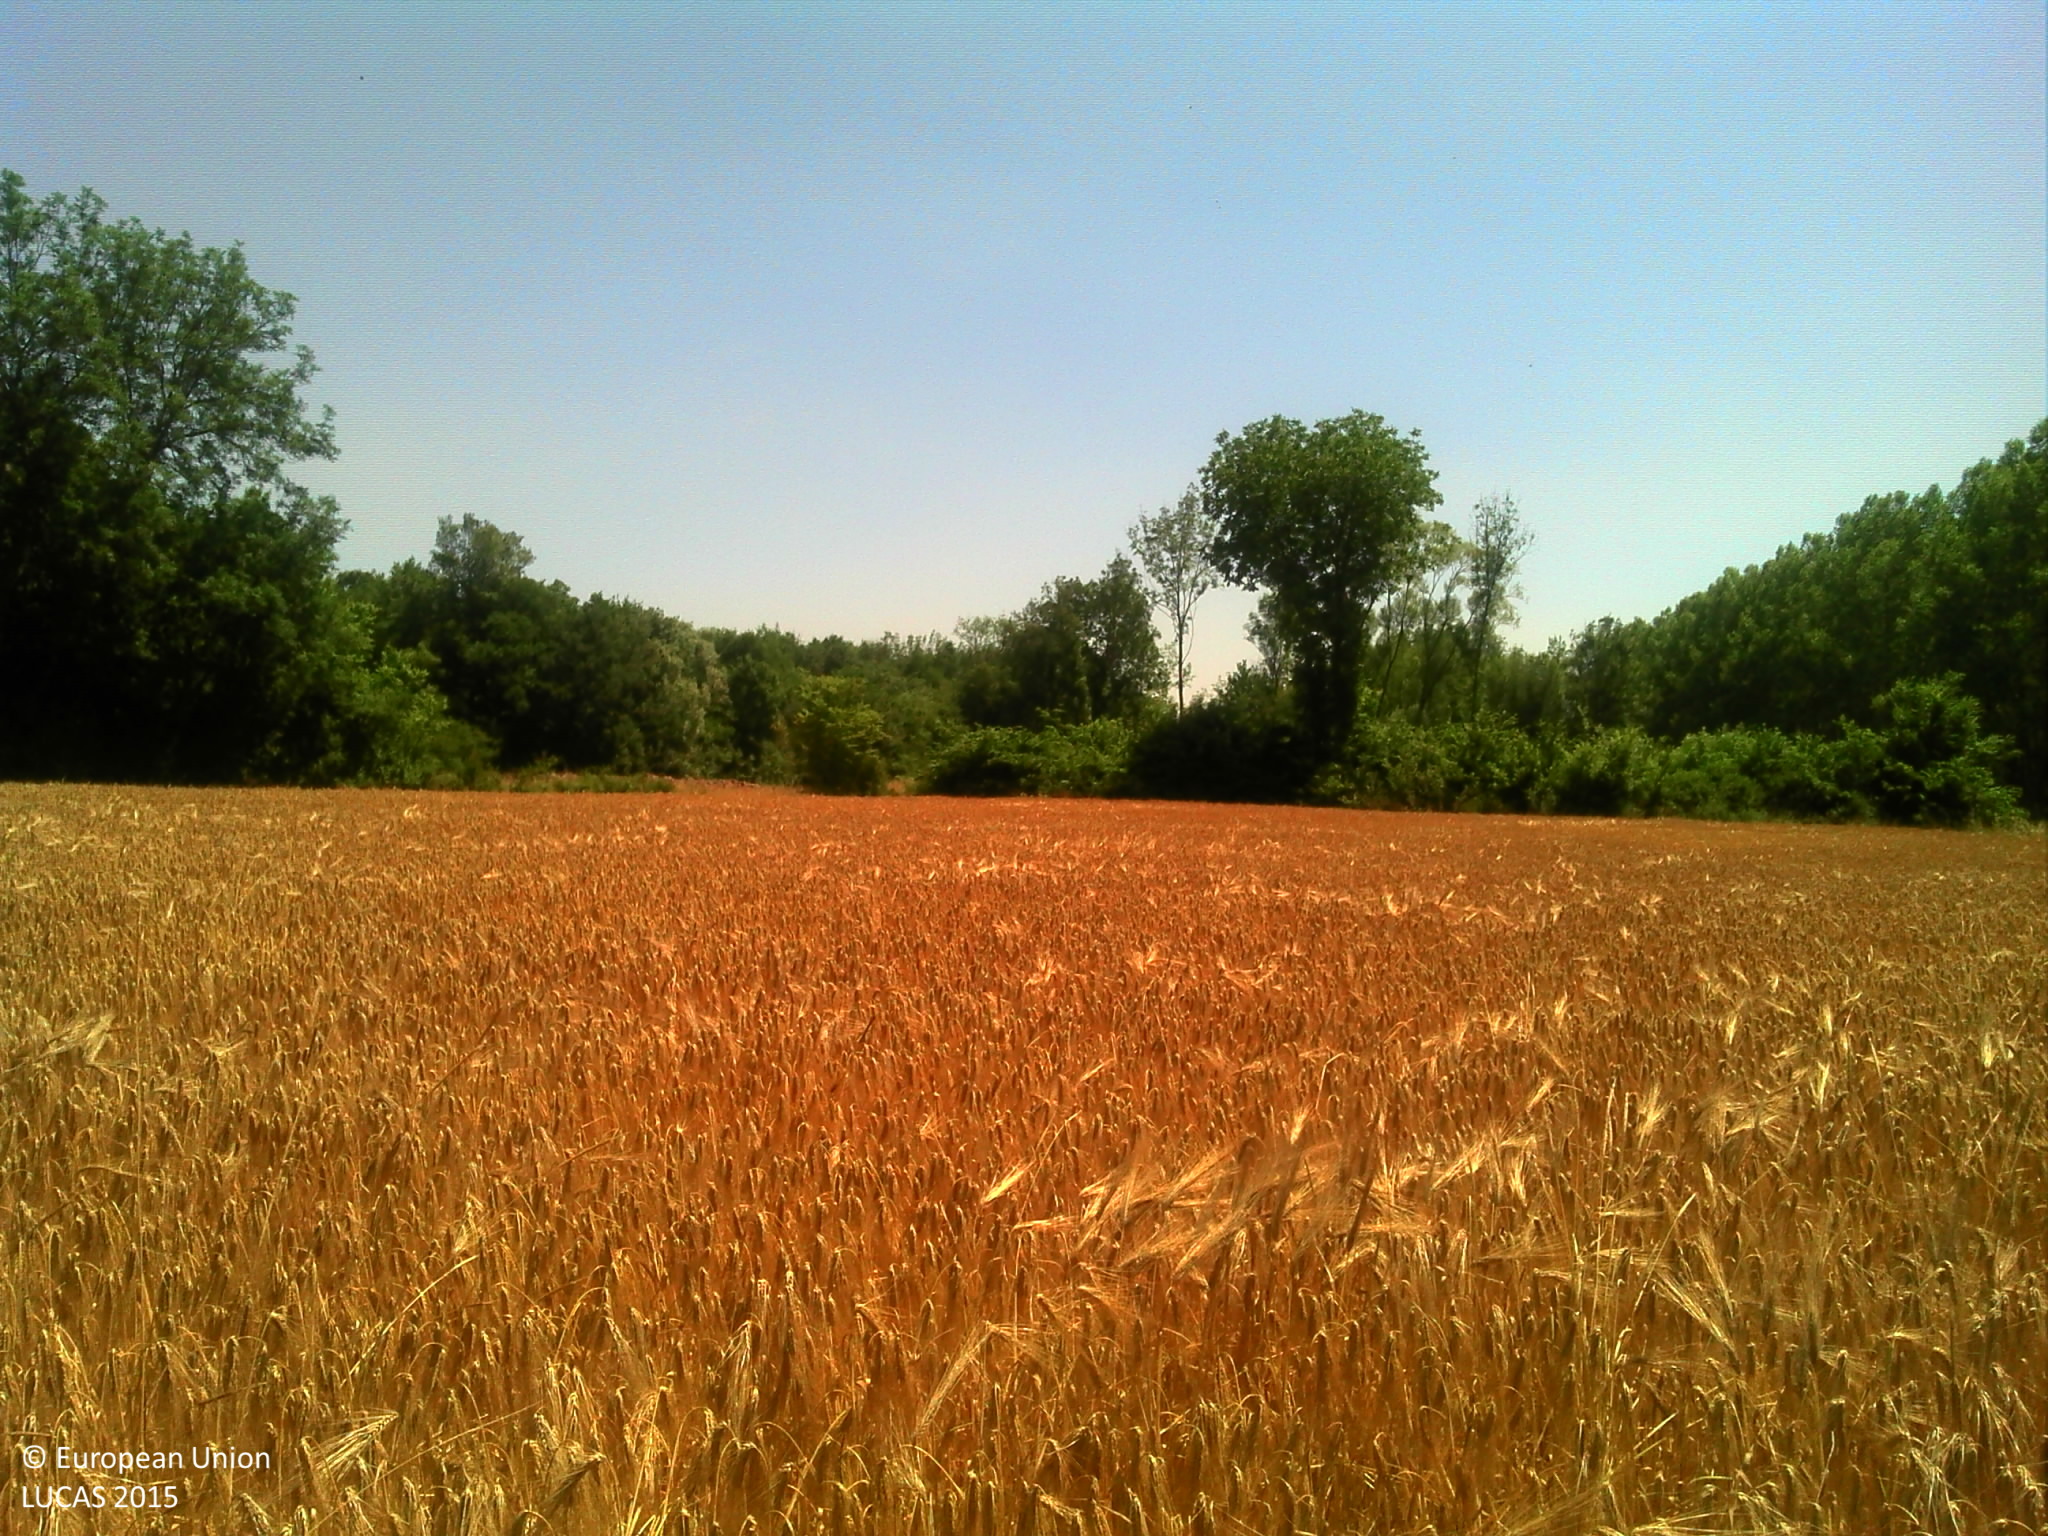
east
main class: Cropland
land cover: Barley
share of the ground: > 75 %
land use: Agriculture (excluding fallow land and kitchen gardens)
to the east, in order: Barley; Managed hedges; Grassland without tree/shrub cover; Ditches and canals; Broadleaved woodland; Tracks; Broadleaved woodland
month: June
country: FR
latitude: 47.1136
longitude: 5.2963
